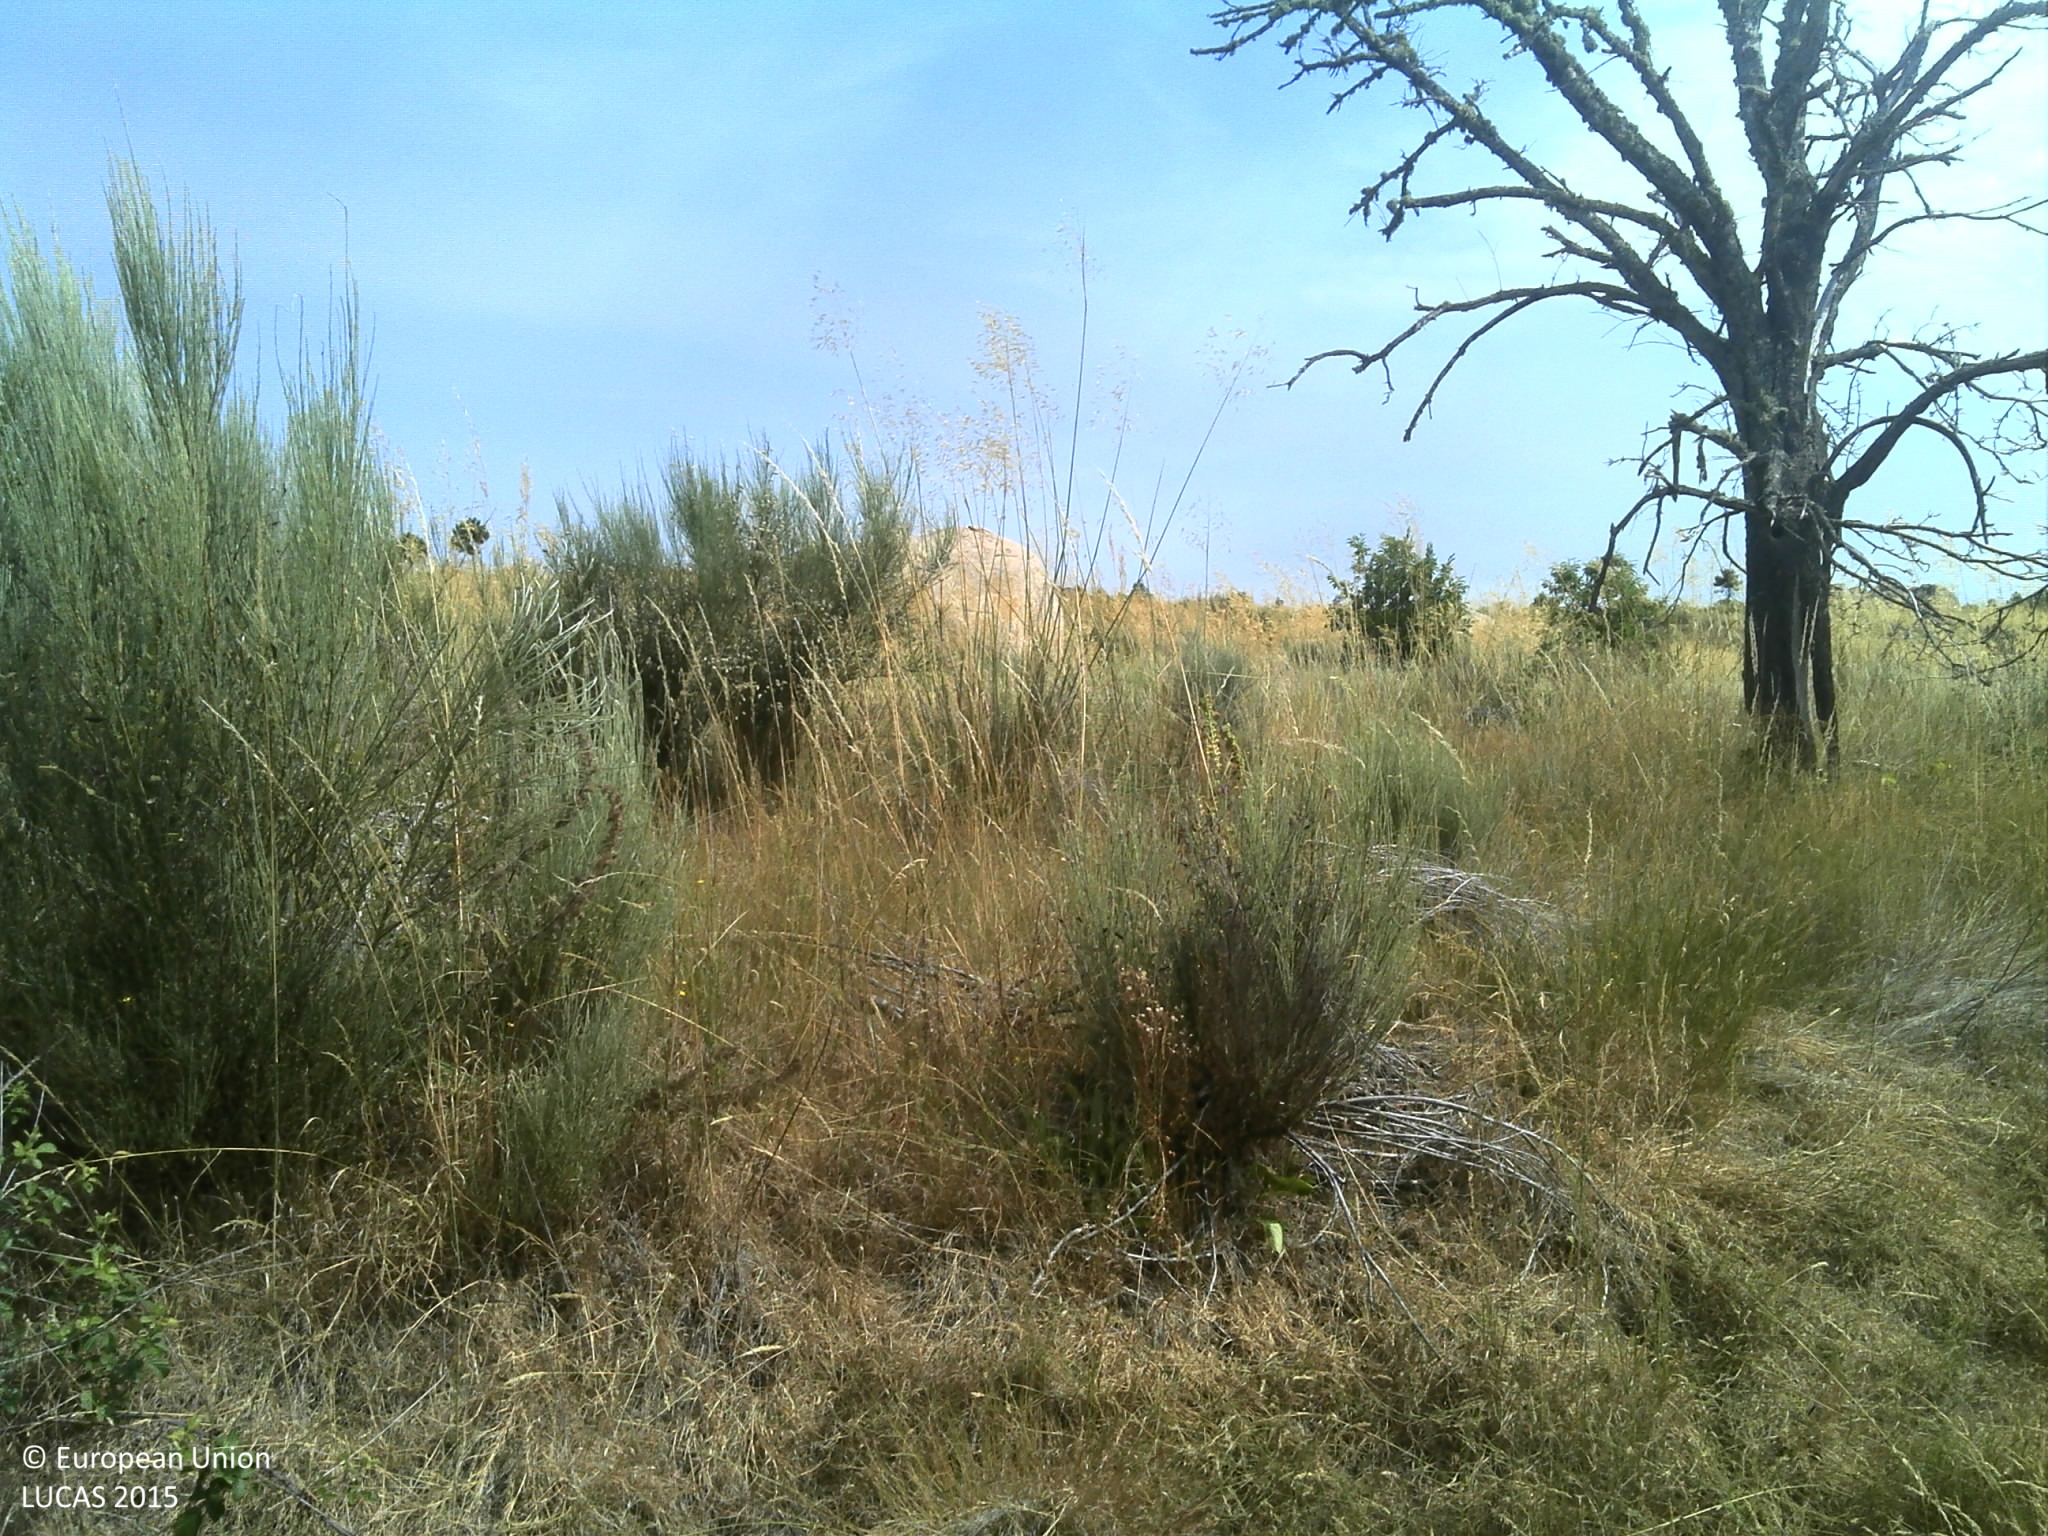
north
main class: Shrubland
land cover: Shrubland without tree cover
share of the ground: 50 - 75 %
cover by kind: shrubs 50 %, unconsolidated bare surface 25 %, herbaceous plants 20 %, consolidated bare surface 5 %
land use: Semi-natural and natural areas not in use
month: July
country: PT
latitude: 40.9322
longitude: -7.3956
